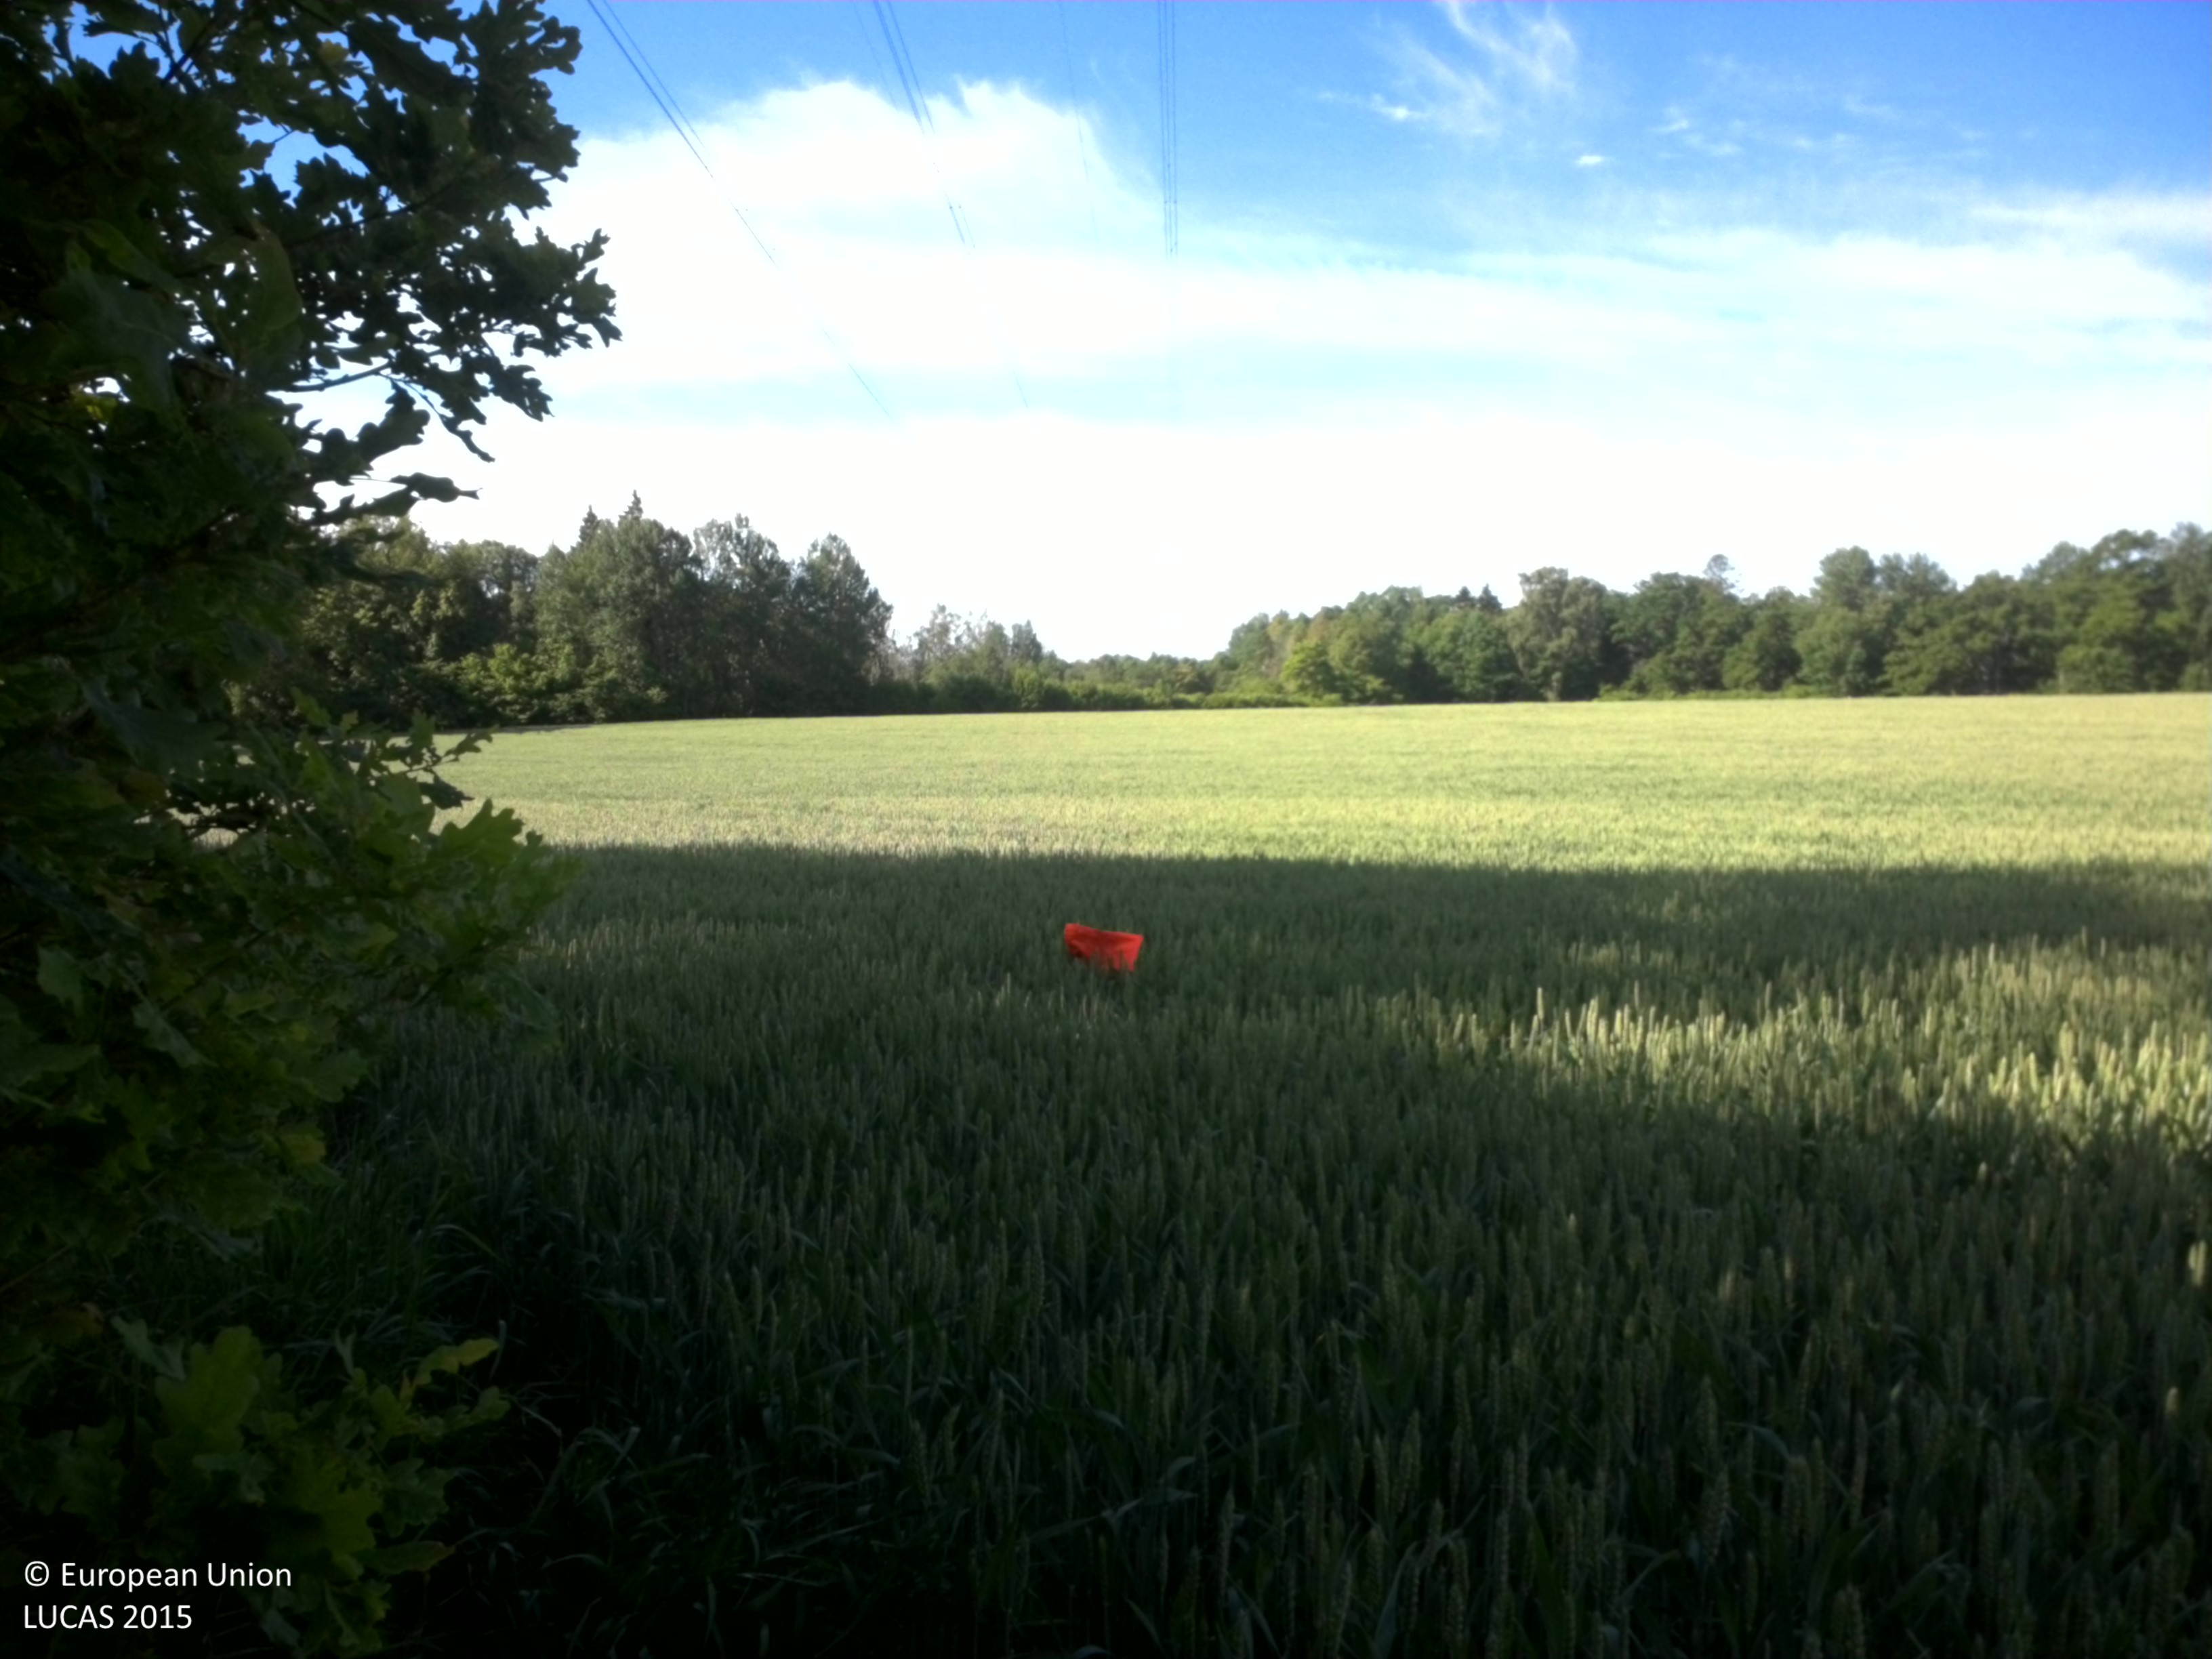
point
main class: Artificial land
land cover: Other artificial areas
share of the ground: > 75 %
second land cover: Common wheat
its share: > 75 %
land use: Electricity, gas and thermal power distribution
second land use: Agriculture (excluding fallow land and kitchen gardens)
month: June
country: SE
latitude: 58.5230
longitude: 15.4714
